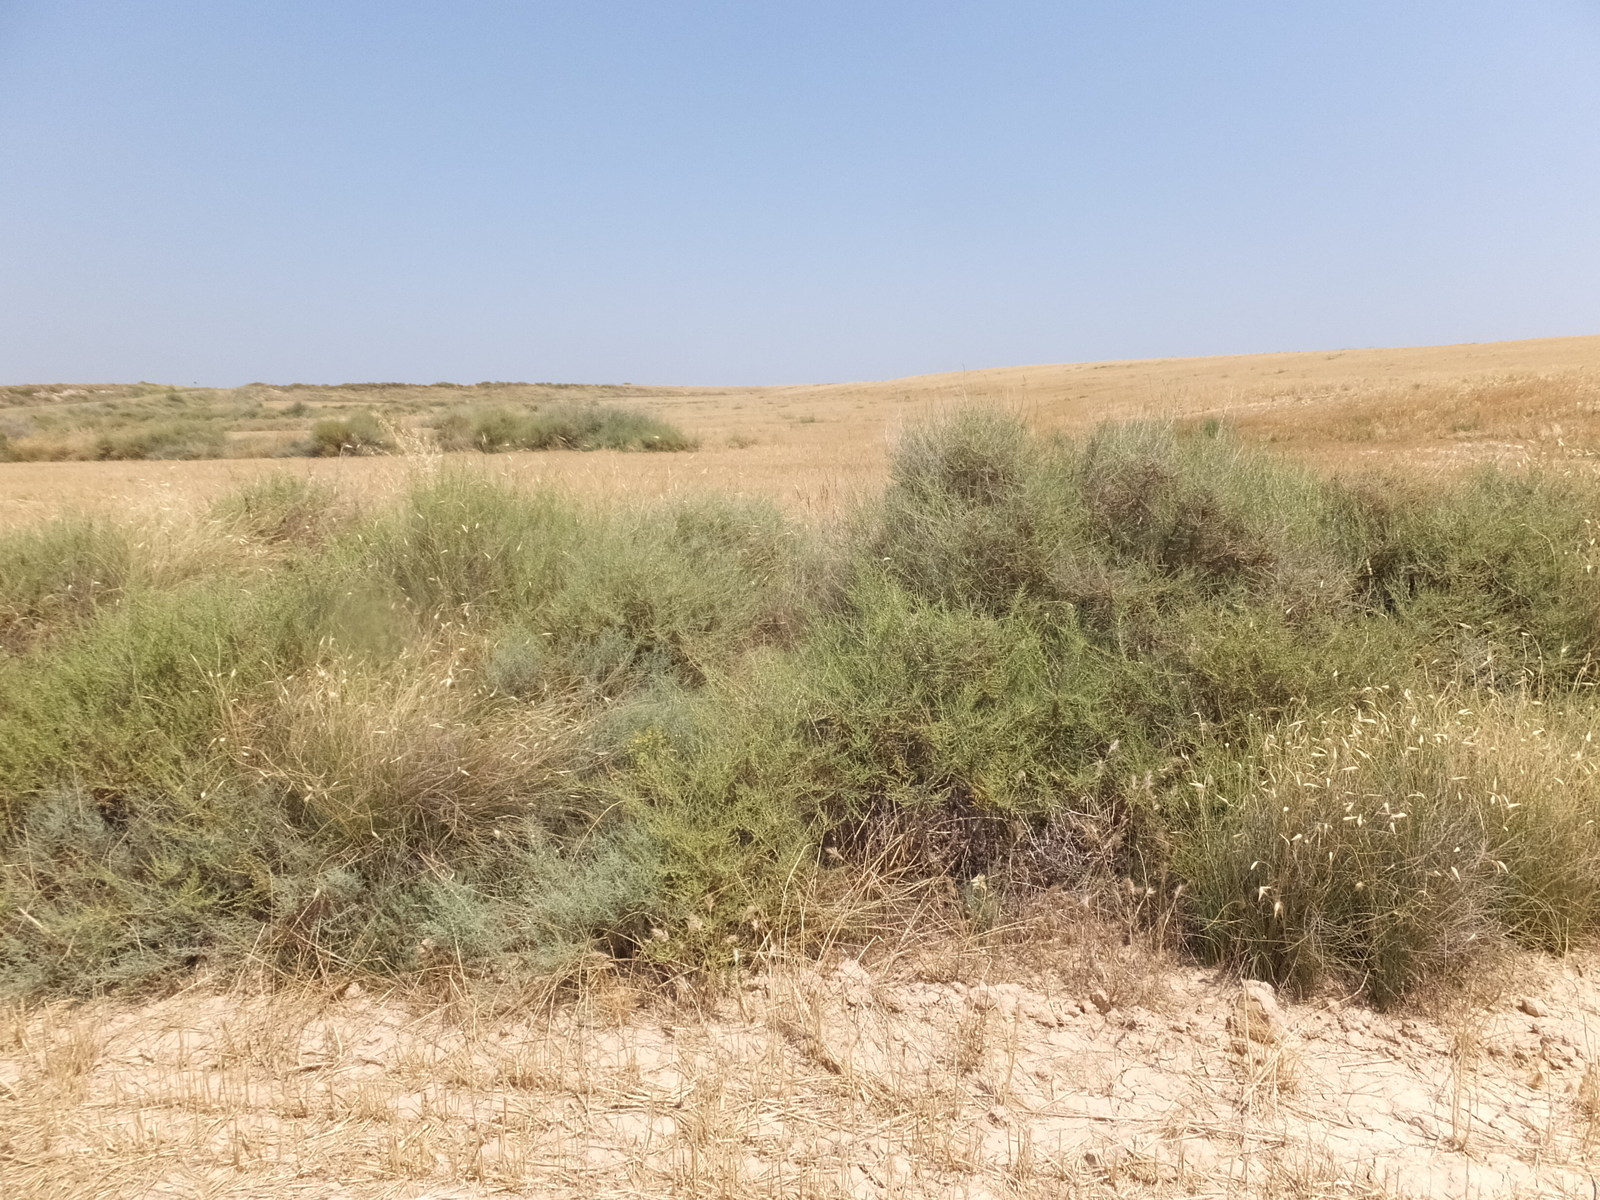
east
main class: Cropland
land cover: Barley
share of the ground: < 10 %
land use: Agriculture (excluding fallow land and kitchen gardens)
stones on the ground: < 10 %
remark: Harvested field
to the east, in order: Barley; Shruby margins; Barley
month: July
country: ES
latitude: 41.6098
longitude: 0.1576
